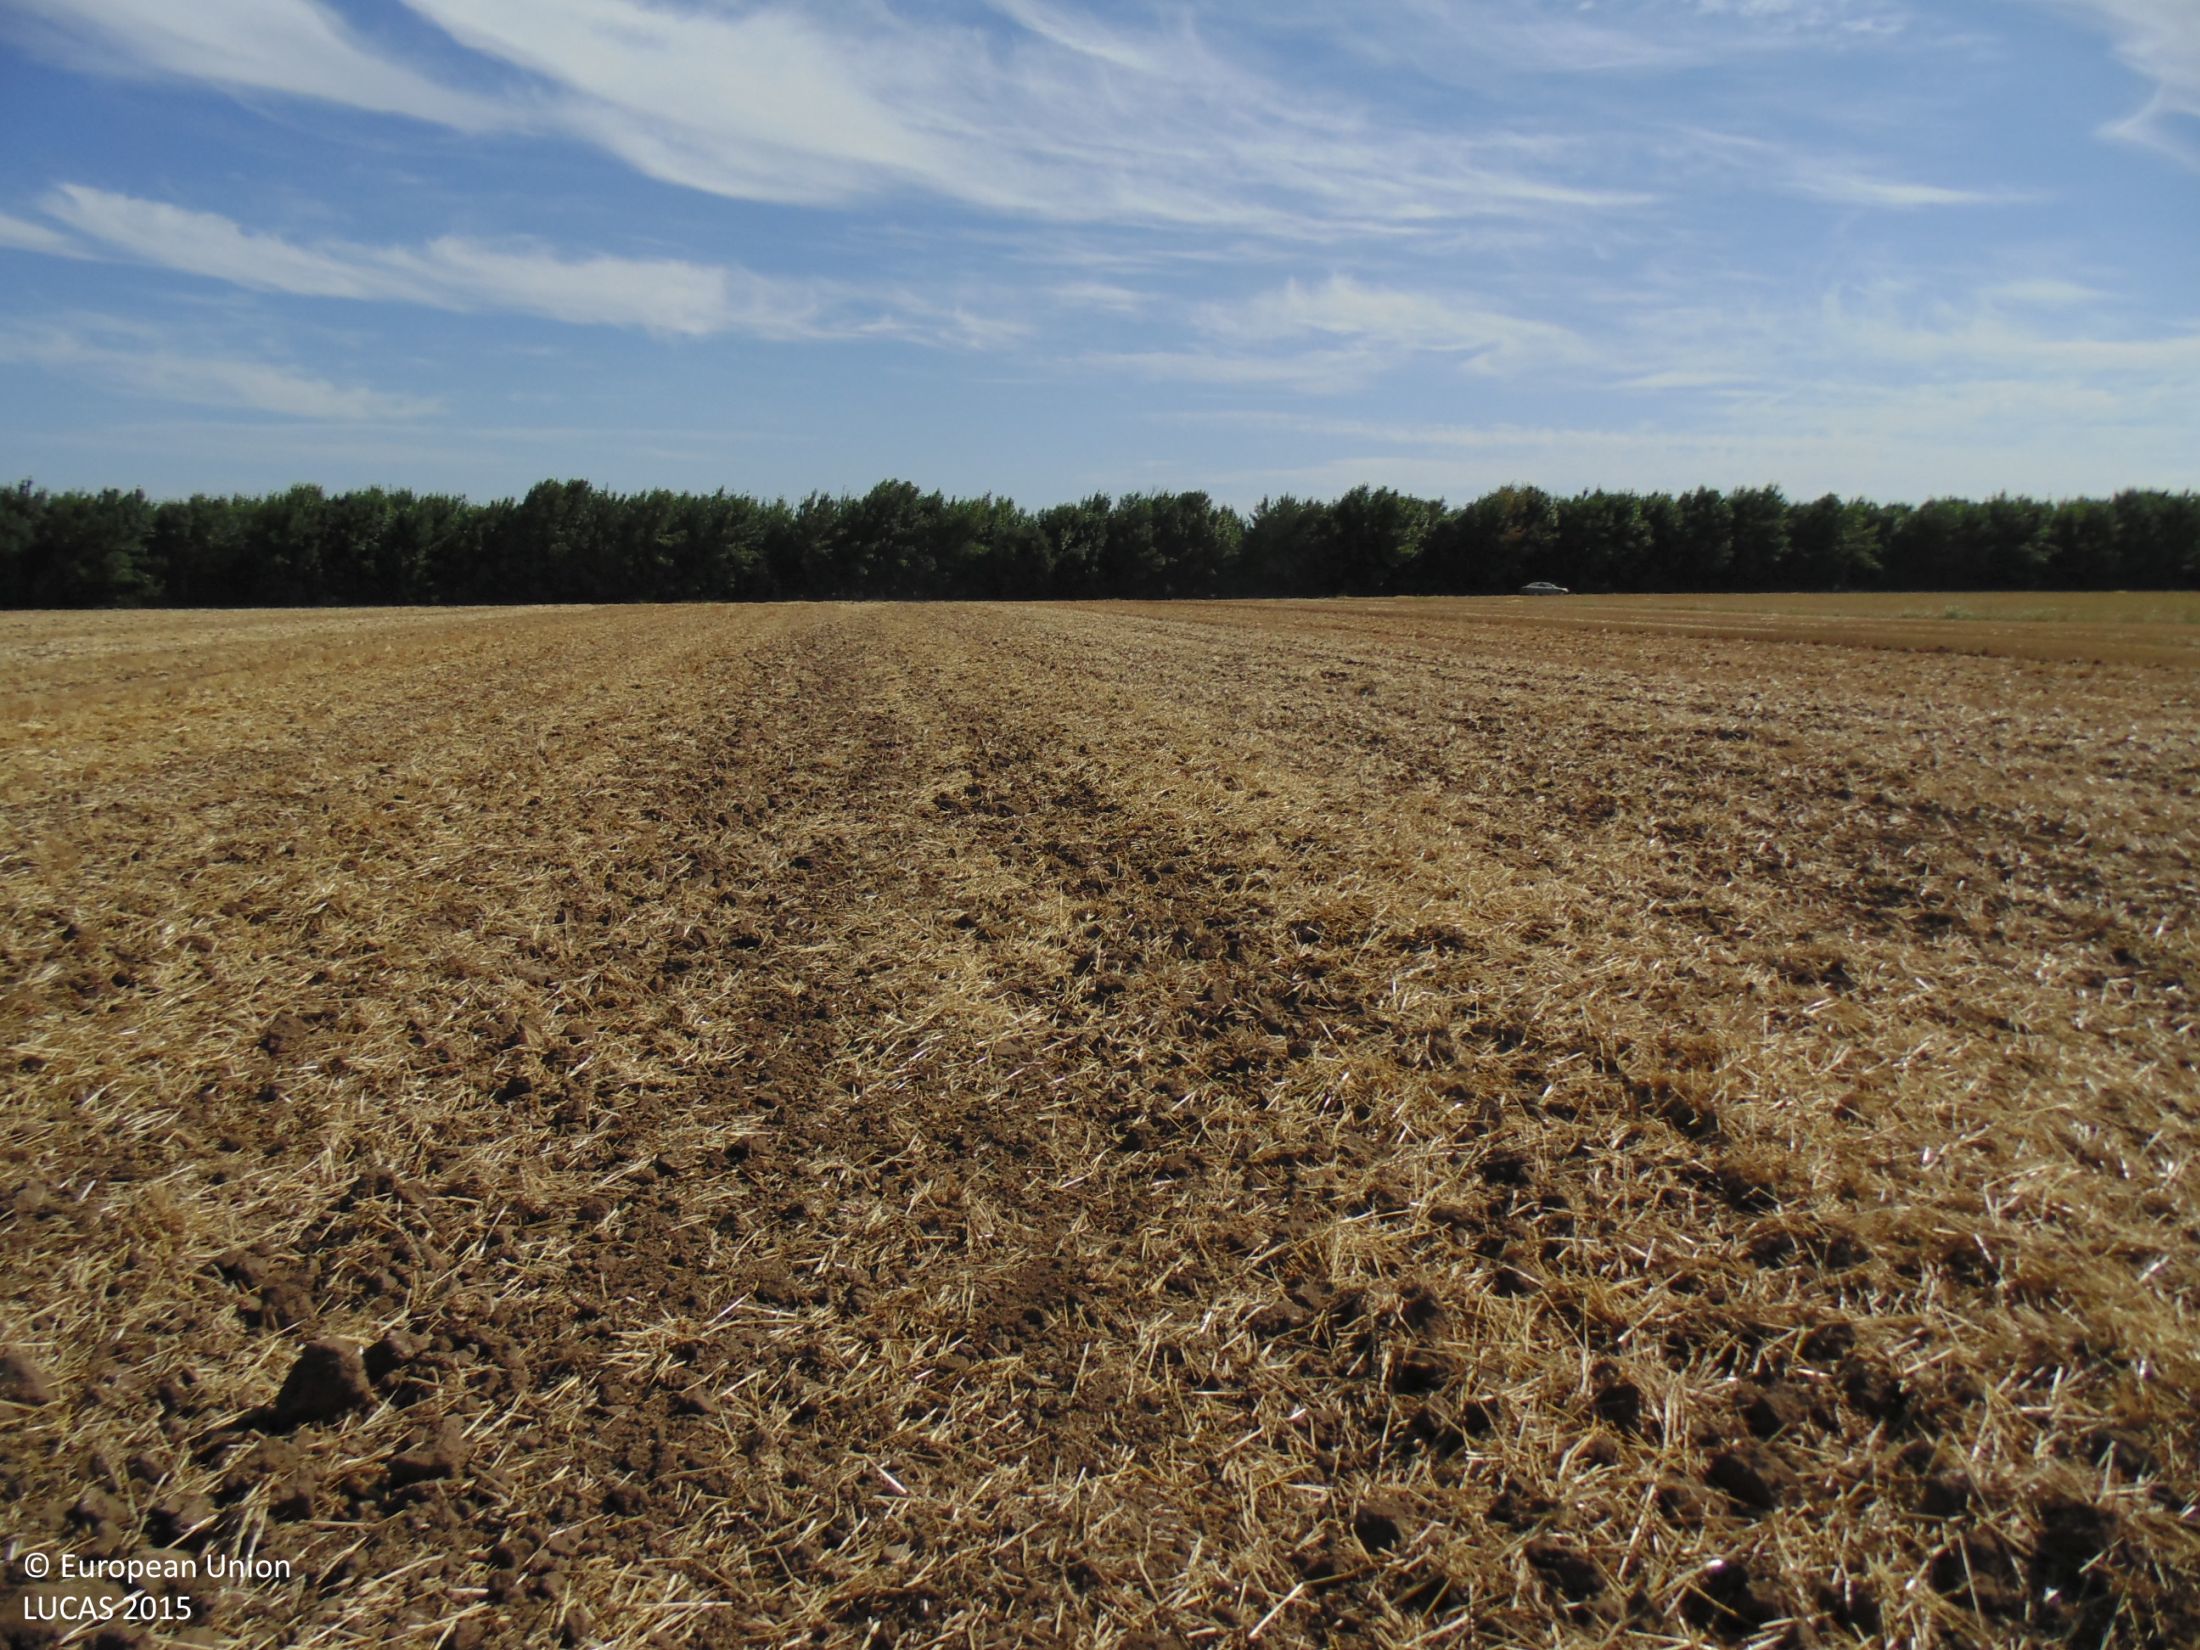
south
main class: Cropland
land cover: Common wheat
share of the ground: < 10 %
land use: Agriculture (excluding fallow land and kitchen gardens)
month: August
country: BG
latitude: 43.8084
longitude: 27.7057
